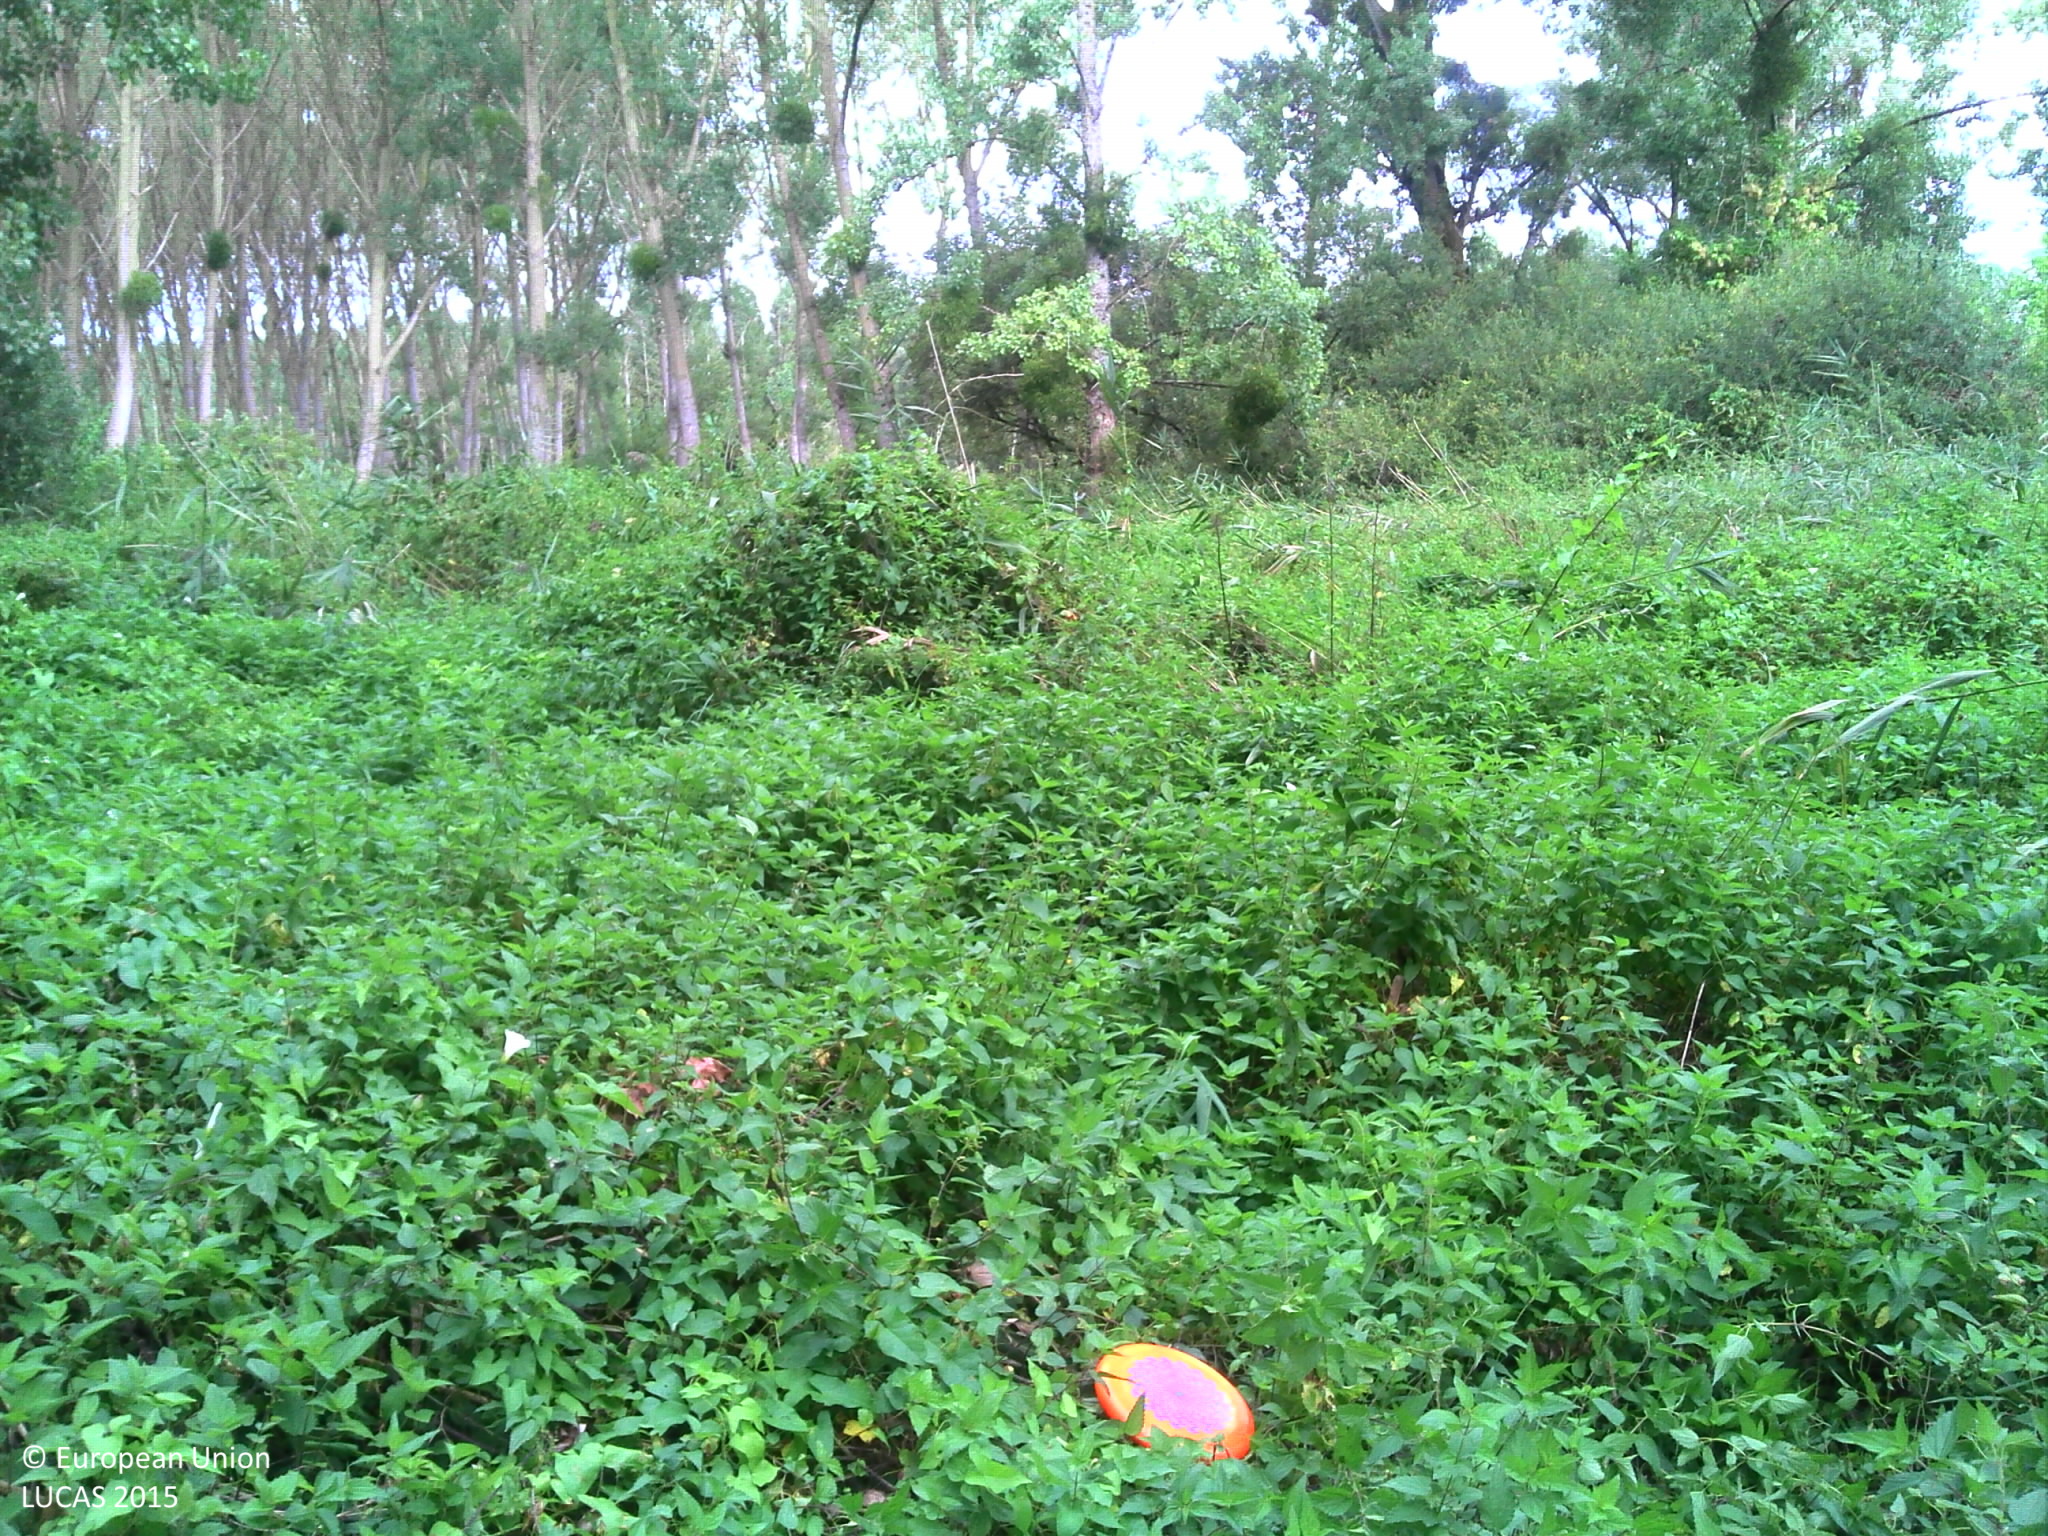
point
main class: Grassland
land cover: Spontaneously vegetated surfaces
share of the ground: > 75 %
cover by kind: herbaceous plants 100 %
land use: Semi-natural and natural areas not in use
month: September
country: FR
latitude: 46.8593
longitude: 1.4490
